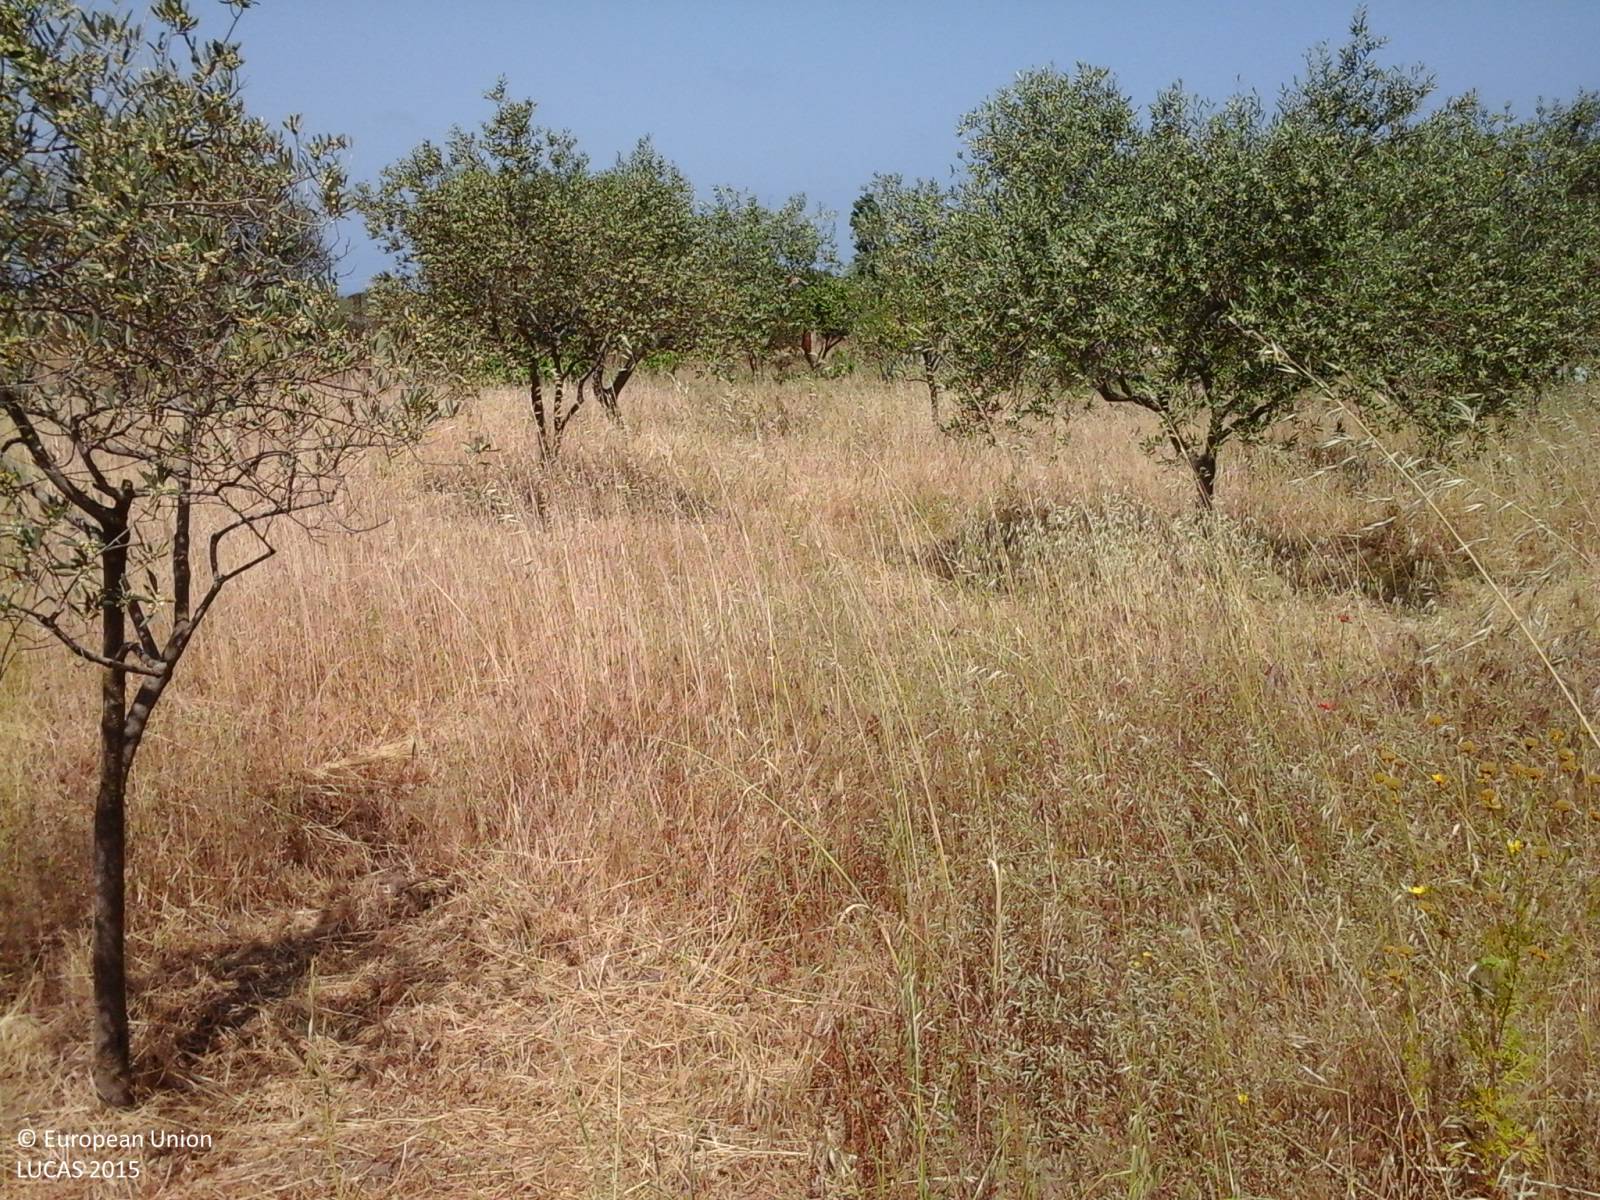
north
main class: Cropland
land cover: Olive groves
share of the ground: 25 - 50 %
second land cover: Spontaneously vegetated surfaces
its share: > 75 %
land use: Agriculture (excluding fallow land and kitchen gardens)
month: May
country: IT
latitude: 40.8180
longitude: 8.5722
